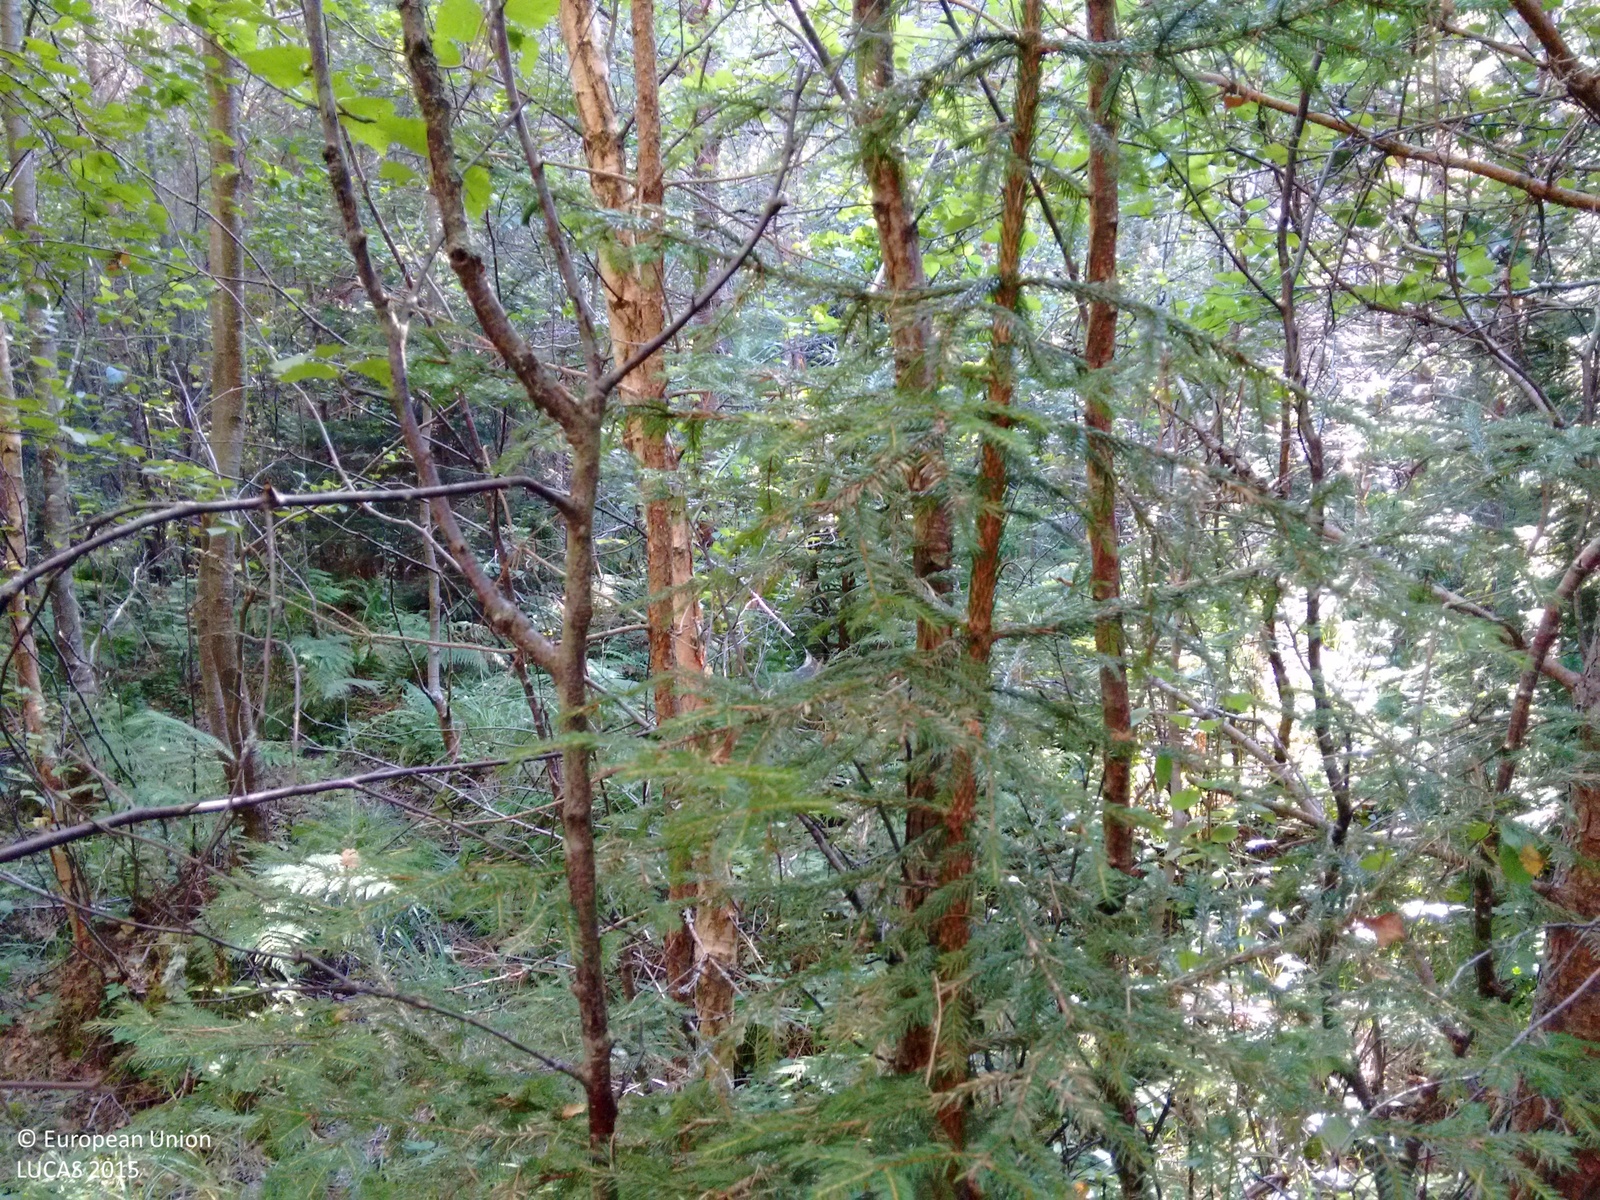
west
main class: Woodland
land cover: Pine dominated mixed woodland
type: hemiboreal forest and nemoral coniferous forest and mixed broadleaved-coniferous forest
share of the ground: > 75 %
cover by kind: coniferous forest trees 55 %, broadleaved forest trees 30 %, herbaceous plants 15 %
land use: Forestry
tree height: > 5 m
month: August
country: FI
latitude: 60.1632
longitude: 19.5717
